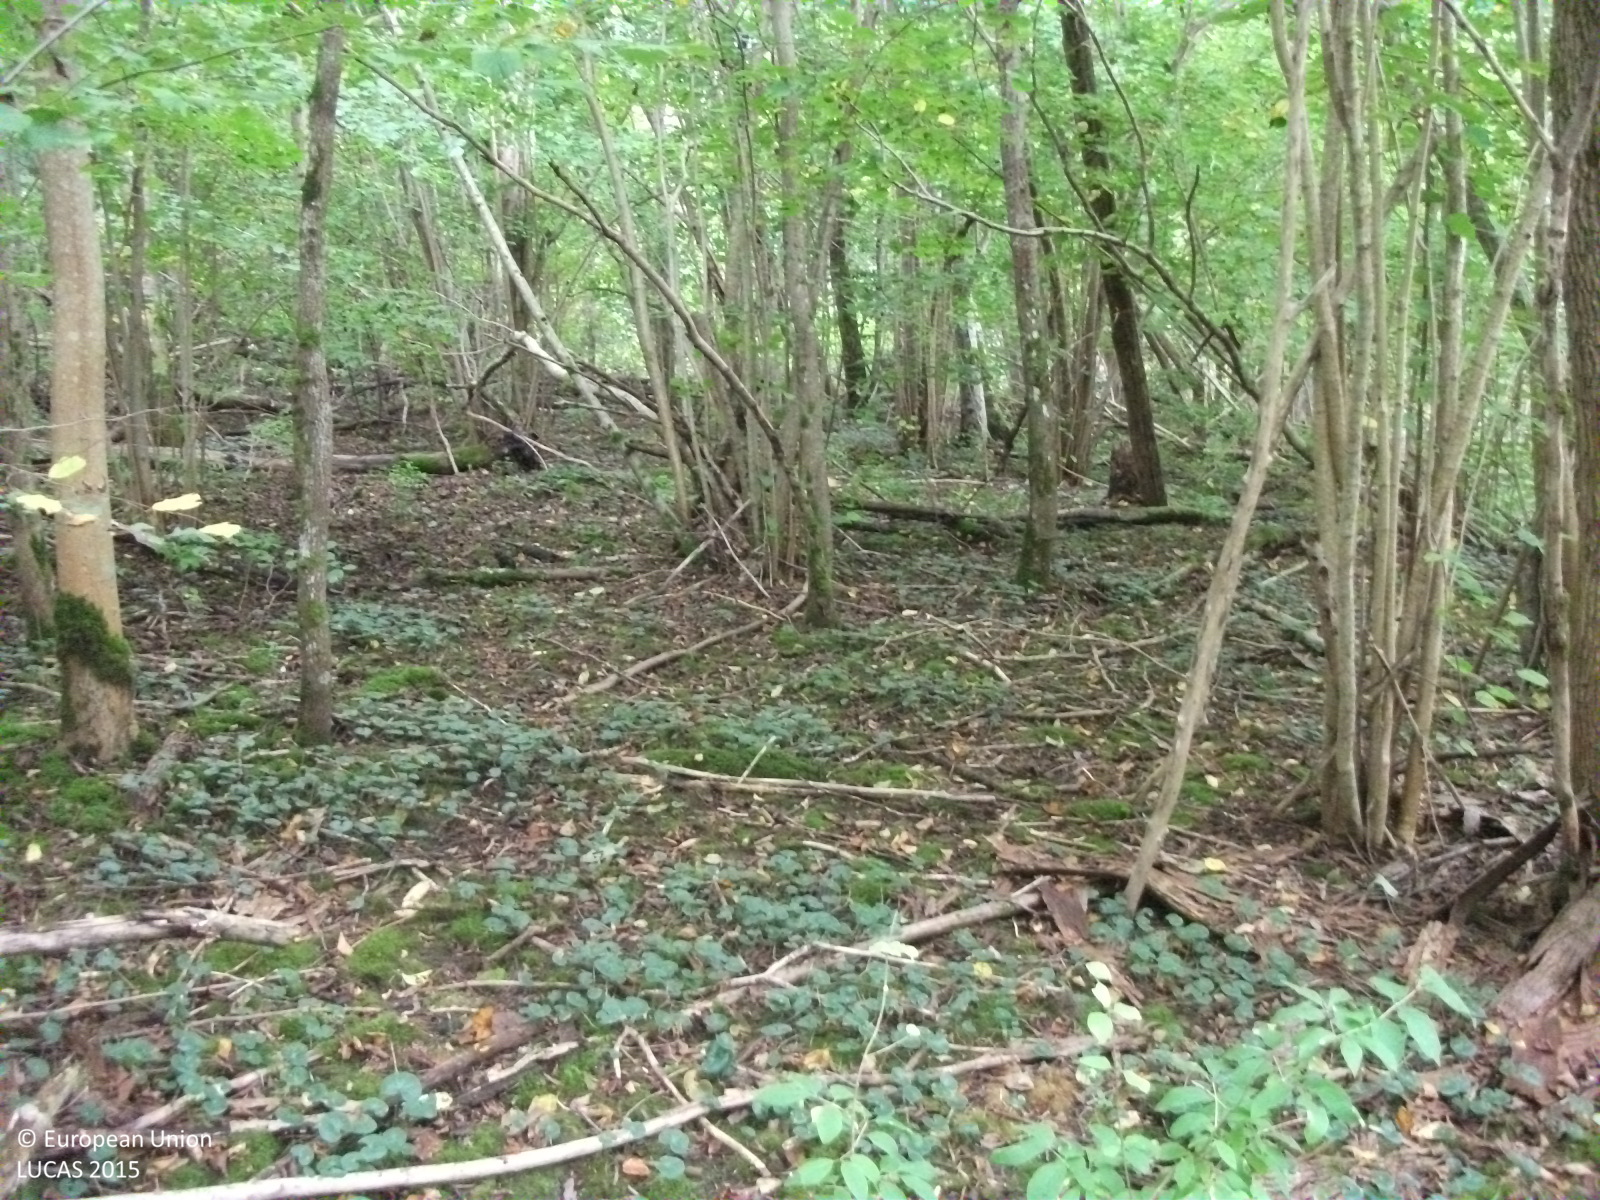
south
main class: Woodland
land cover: Broadleaved woodland
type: floodplain forest
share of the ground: 50 - 75 %
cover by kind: broadleaved forest trees 70 %, herbaceous plants 10 %, shrubs 5 %, lichens and mosses 5 %, unconsolidated bare surface 5 %
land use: Semi-natural and natural areas not in use
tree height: > 5 m
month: September
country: LV
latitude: 57.7614
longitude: 24.4592
